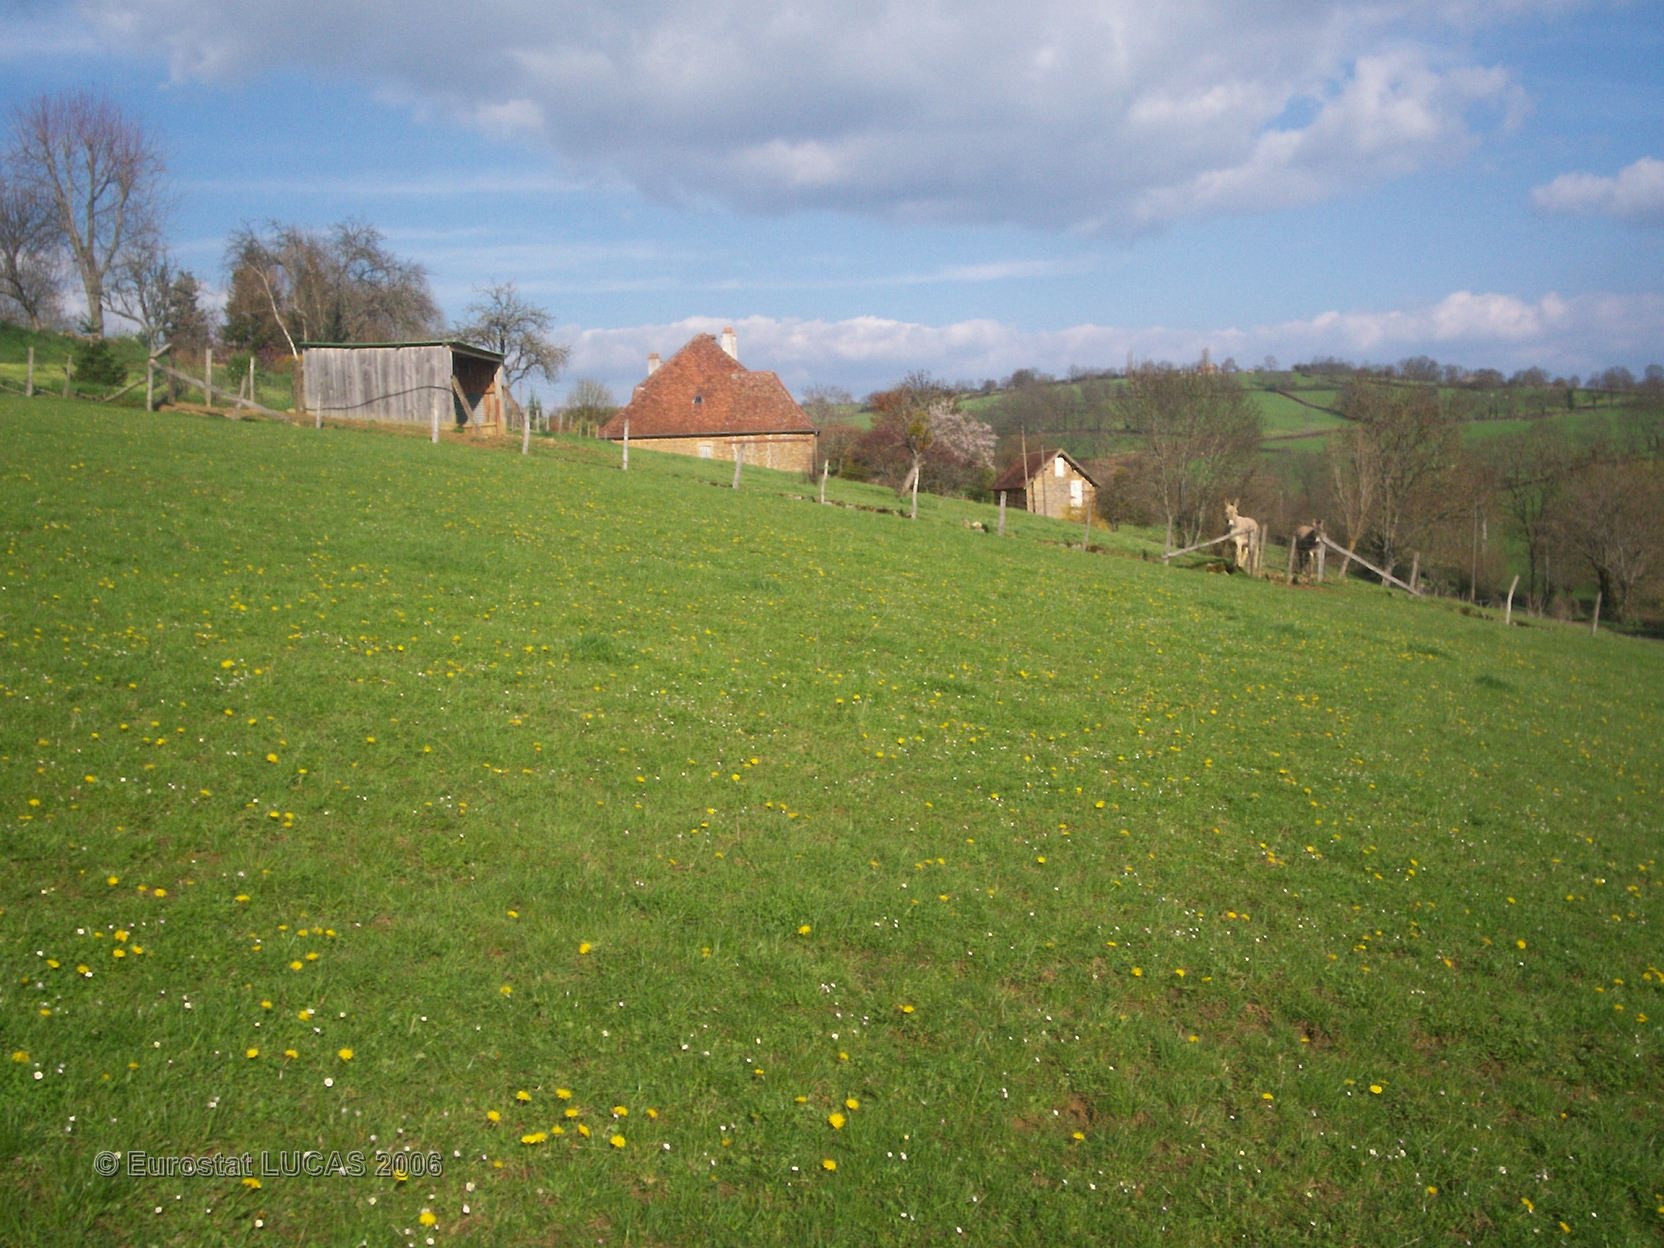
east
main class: Grassland
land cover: Grassland without tree/shrub cover
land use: Agriculture (excluding fallow land and kitchen gardens)
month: April
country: FR
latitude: 46.2260
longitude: 4.1280
